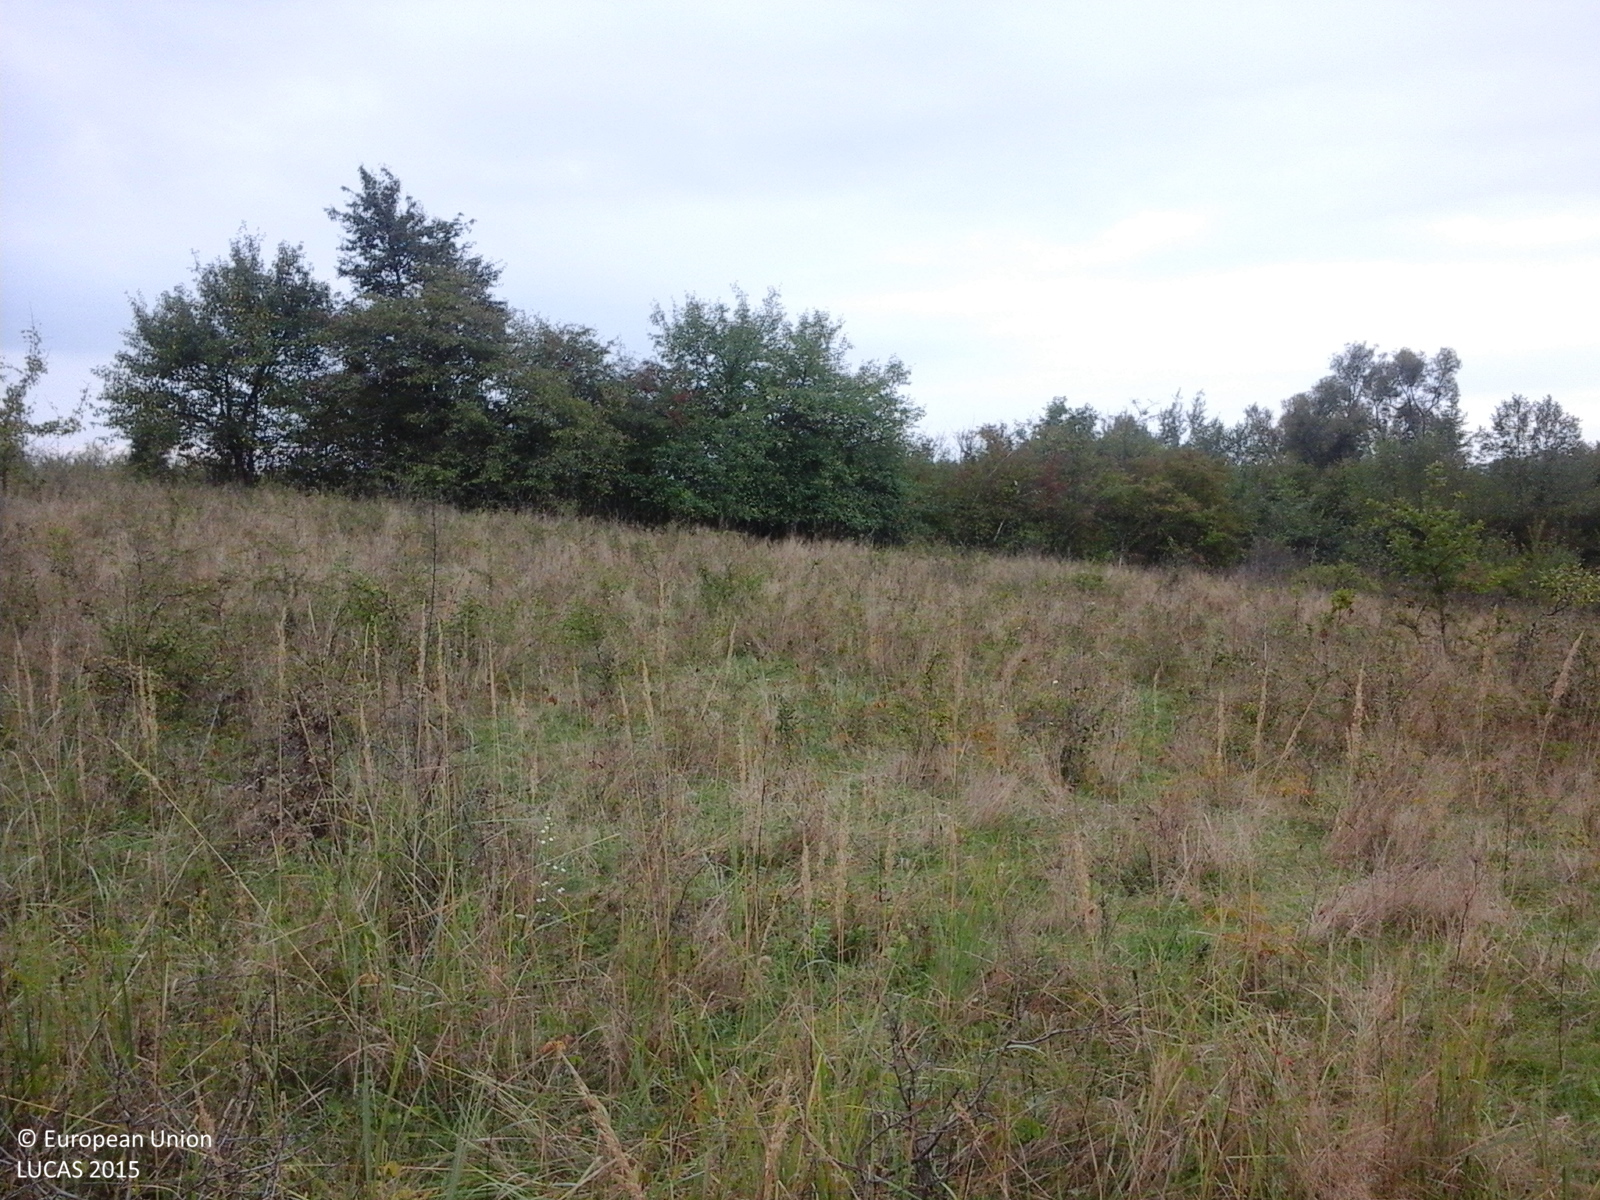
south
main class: Grassland
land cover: Spontaneously vegetated surfaces
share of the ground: > 75 %
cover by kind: herbaceous plants 100 %
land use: Fallow land
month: September
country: RO
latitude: 45.9552
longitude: 22.2369
